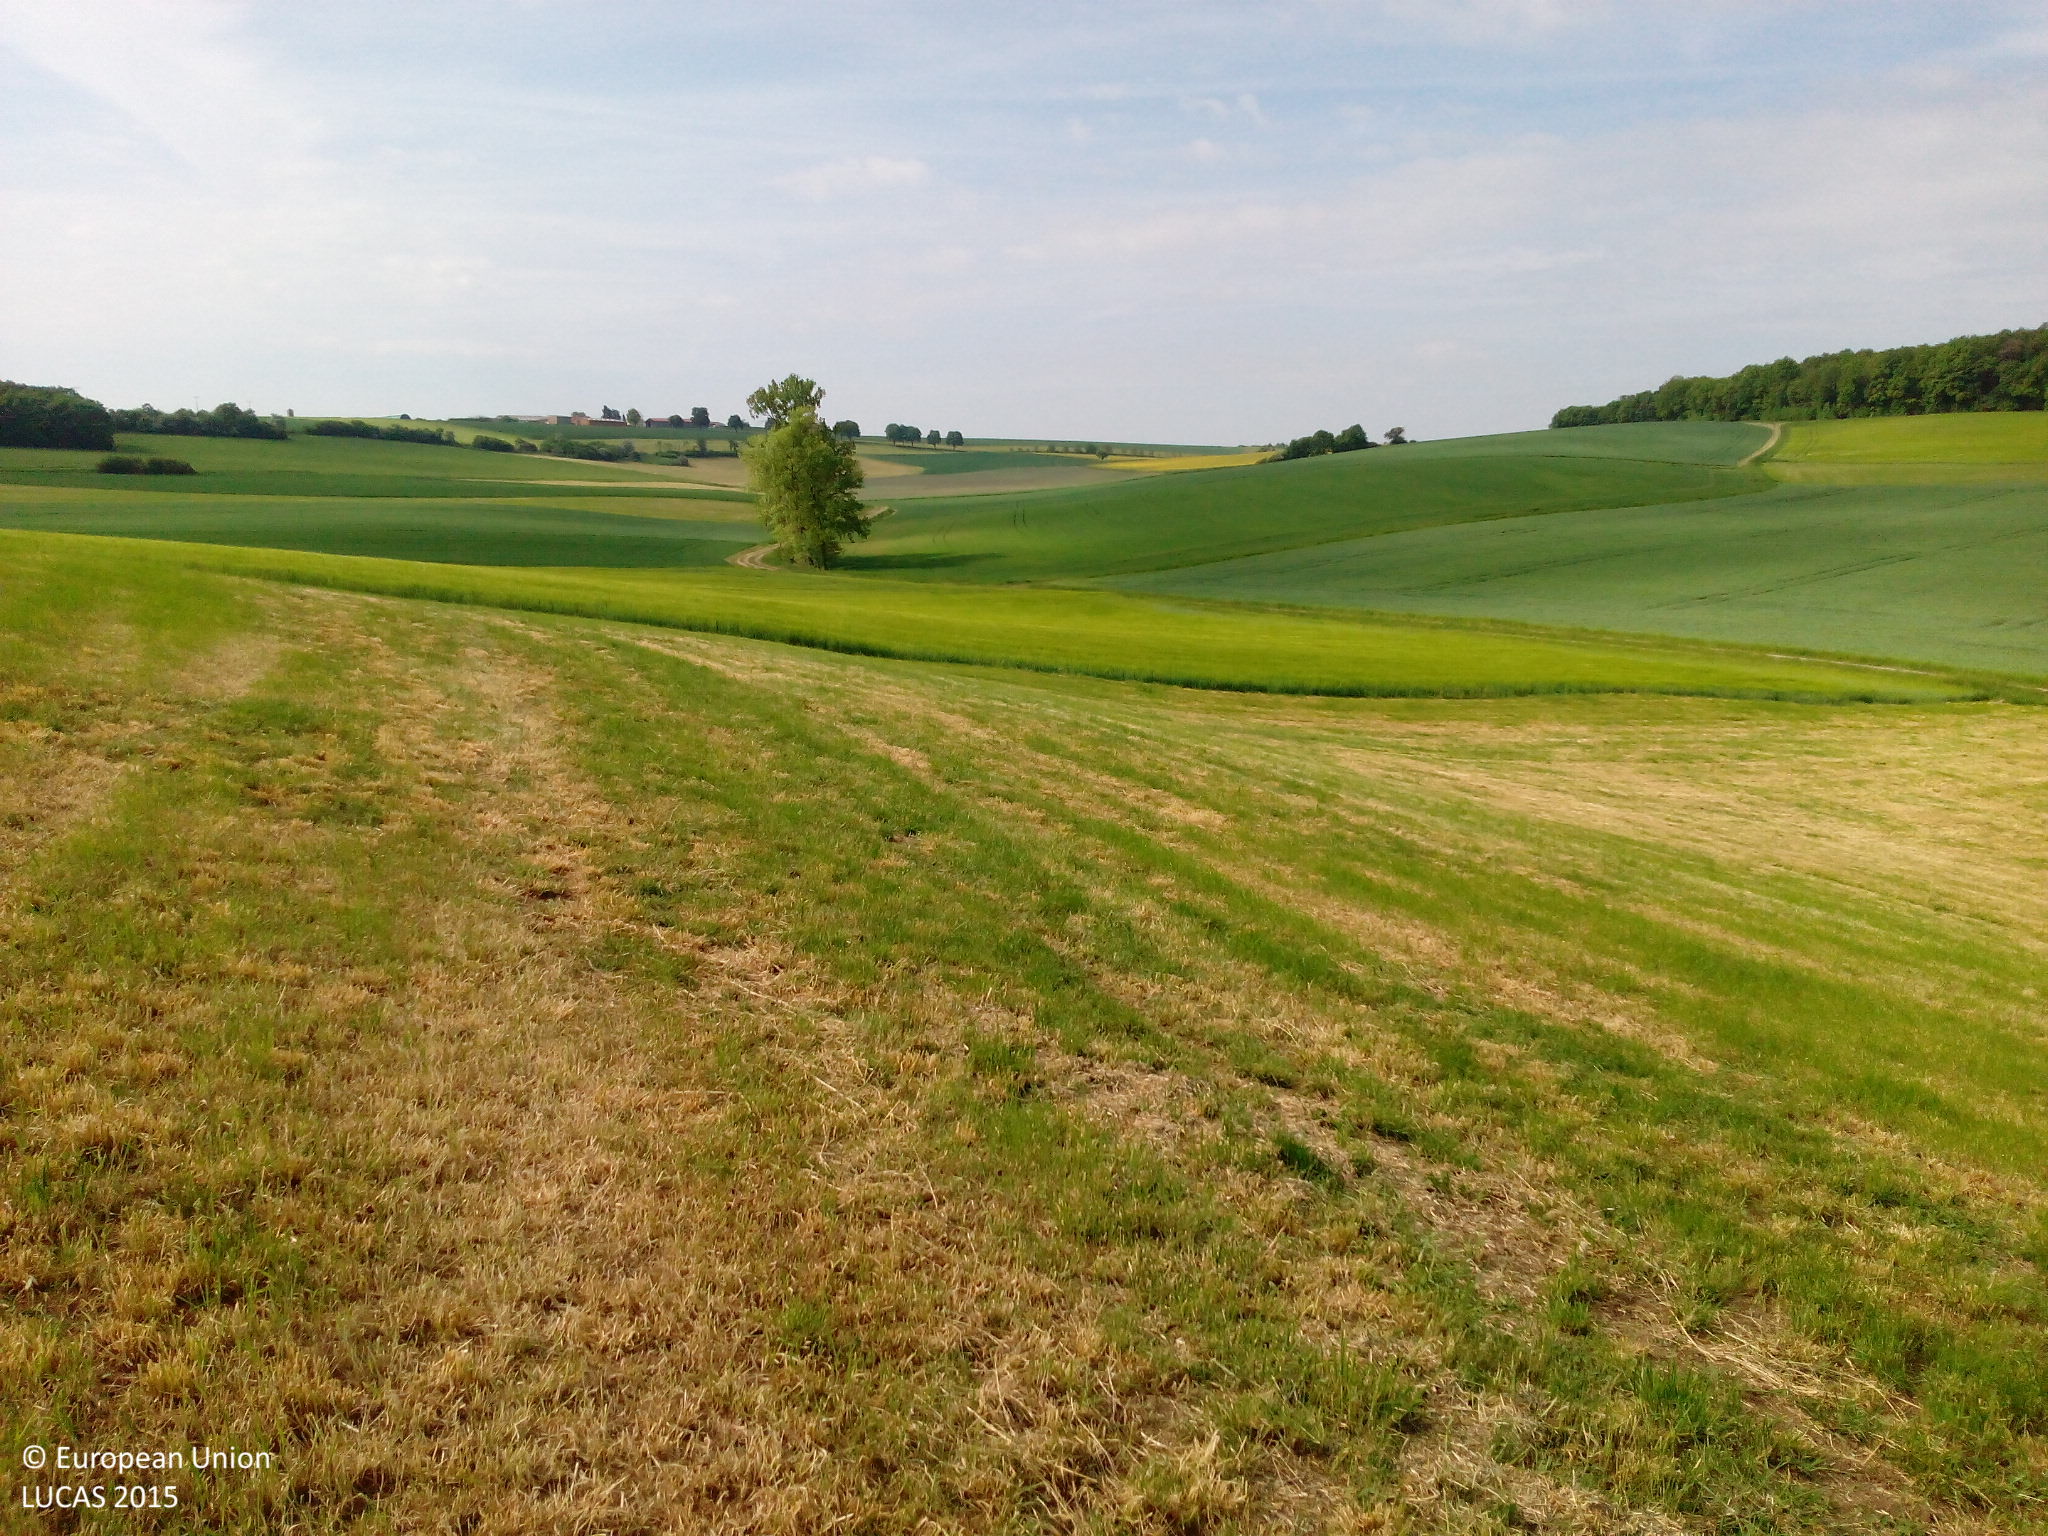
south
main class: Grassland
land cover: Grassland without tree/shrub cover
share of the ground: > 75 %
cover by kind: herbaceous plants 100 %
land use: Agriculture (excluding fallow land and kitchen gardens)
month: May
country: DE
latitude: 50.1444
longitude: 10.9373
